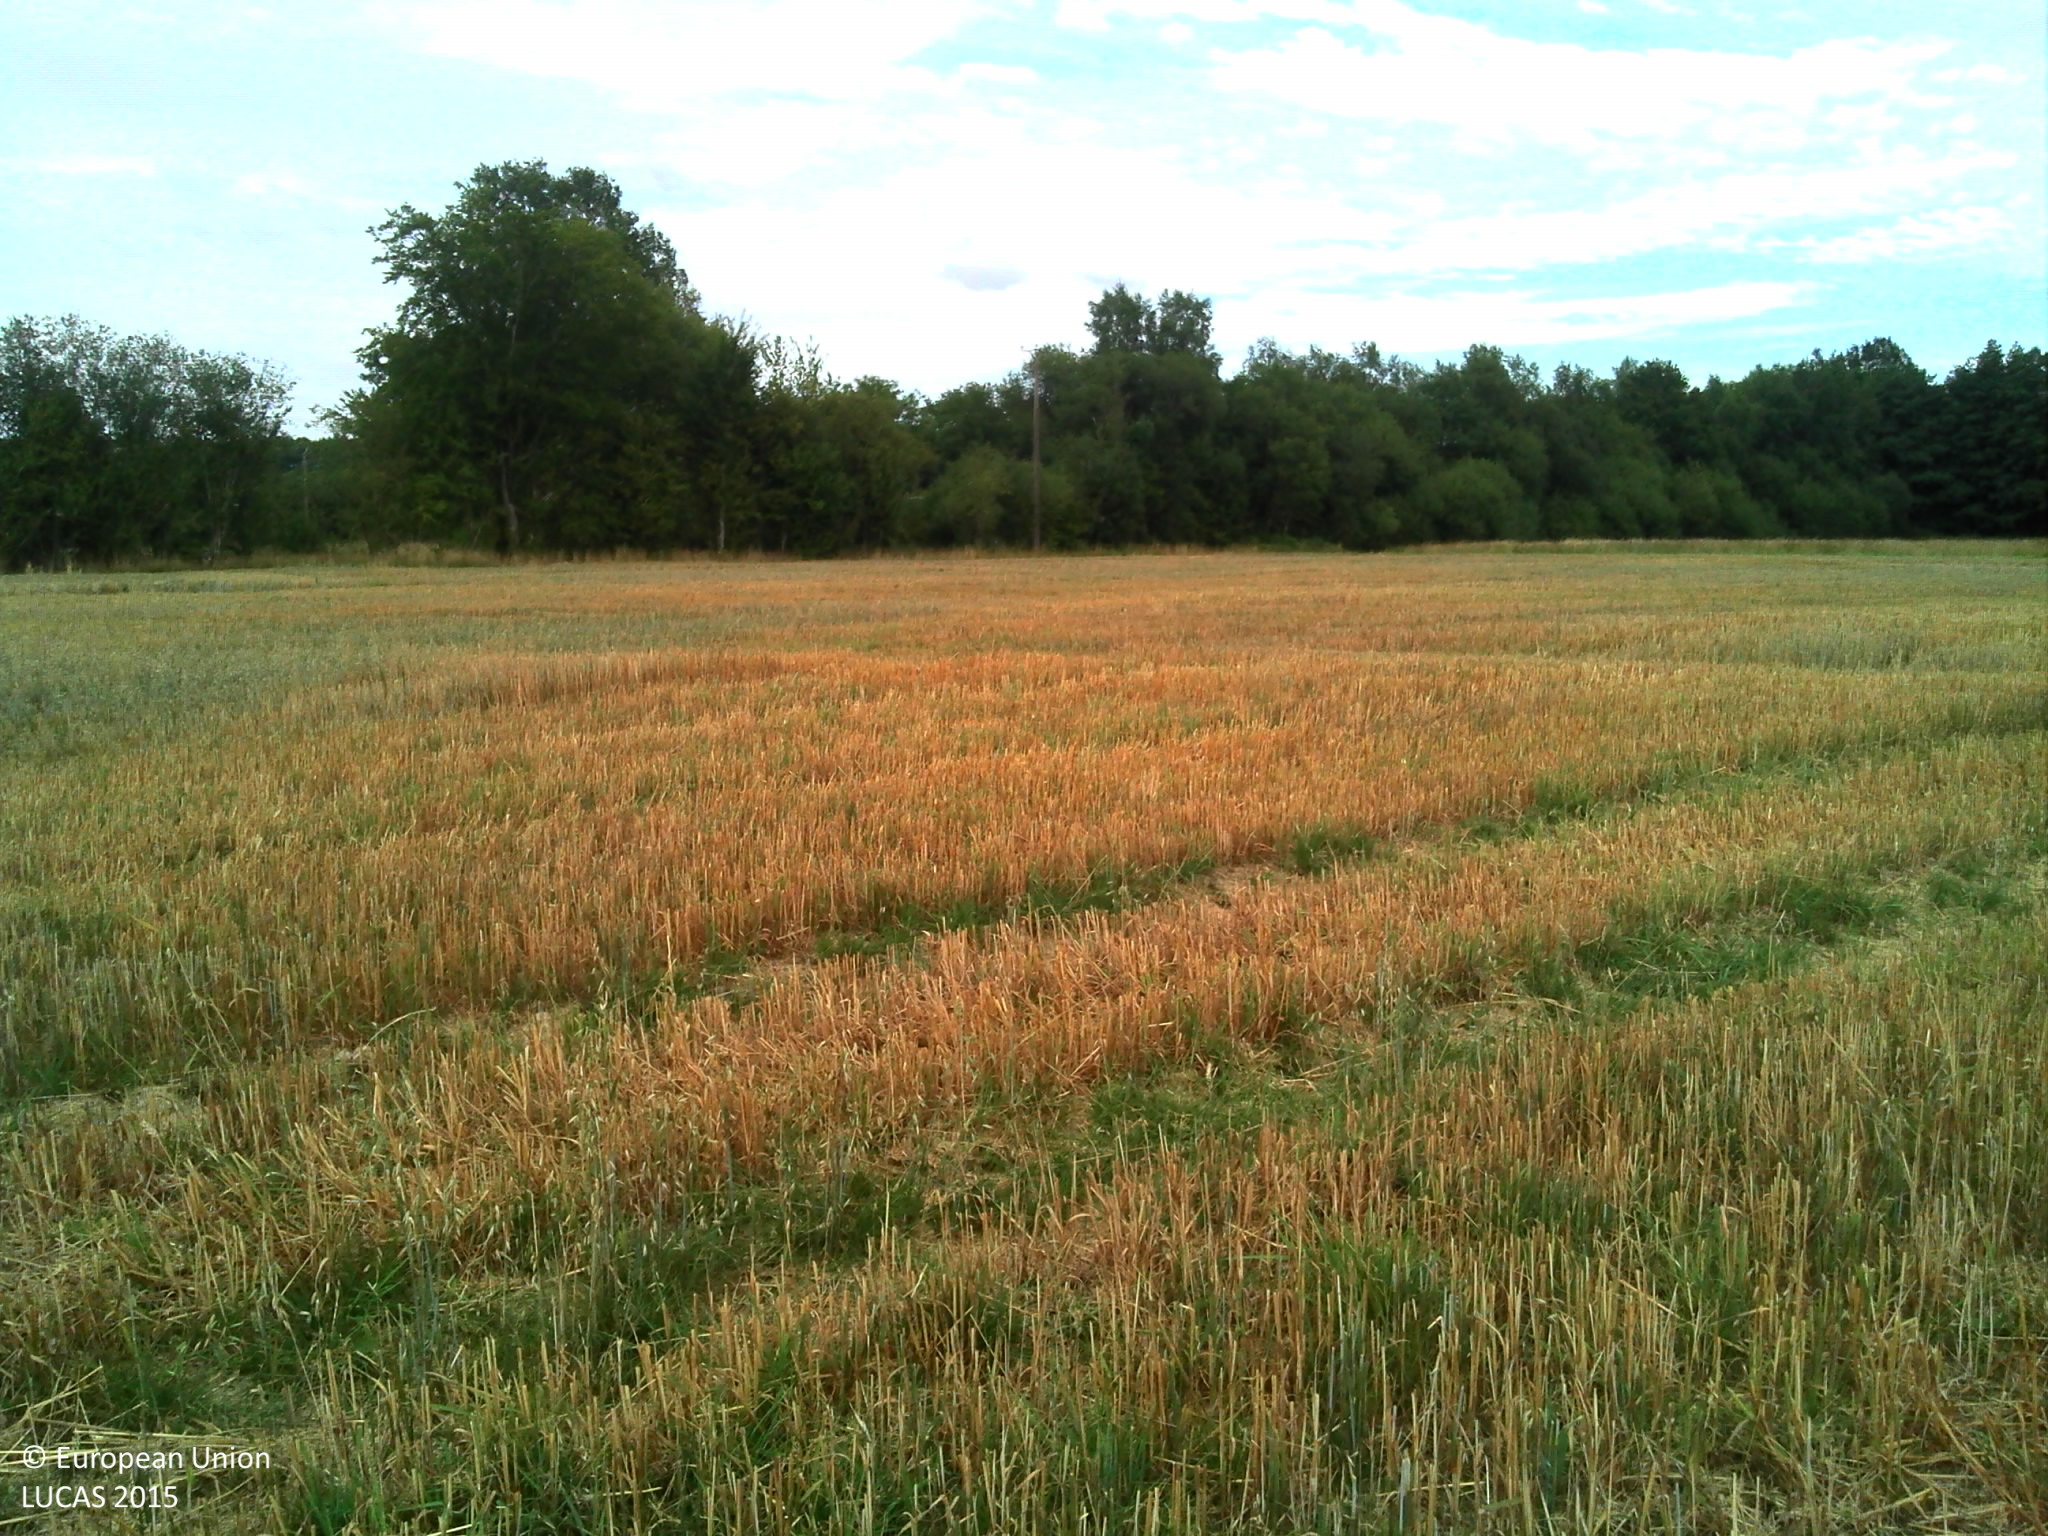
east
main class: Cropland
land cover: Oats
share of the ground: > 75 %
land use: Agriculture (excluding fallow land and kitchen gardens)
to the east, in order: Oats; Abandoned hedges; Electric lines; Tracks; Abandoned hedges; Grassland without tree/shrub cover; Lines of trees; Grassland without tree/shrub cover; Electric lines; Grassland without tree/shrub cover; Lines of trees; Grassland without tree/shrub cover; Managed hedges
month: July
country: FR
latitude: 48.6958
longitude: 0.4504
